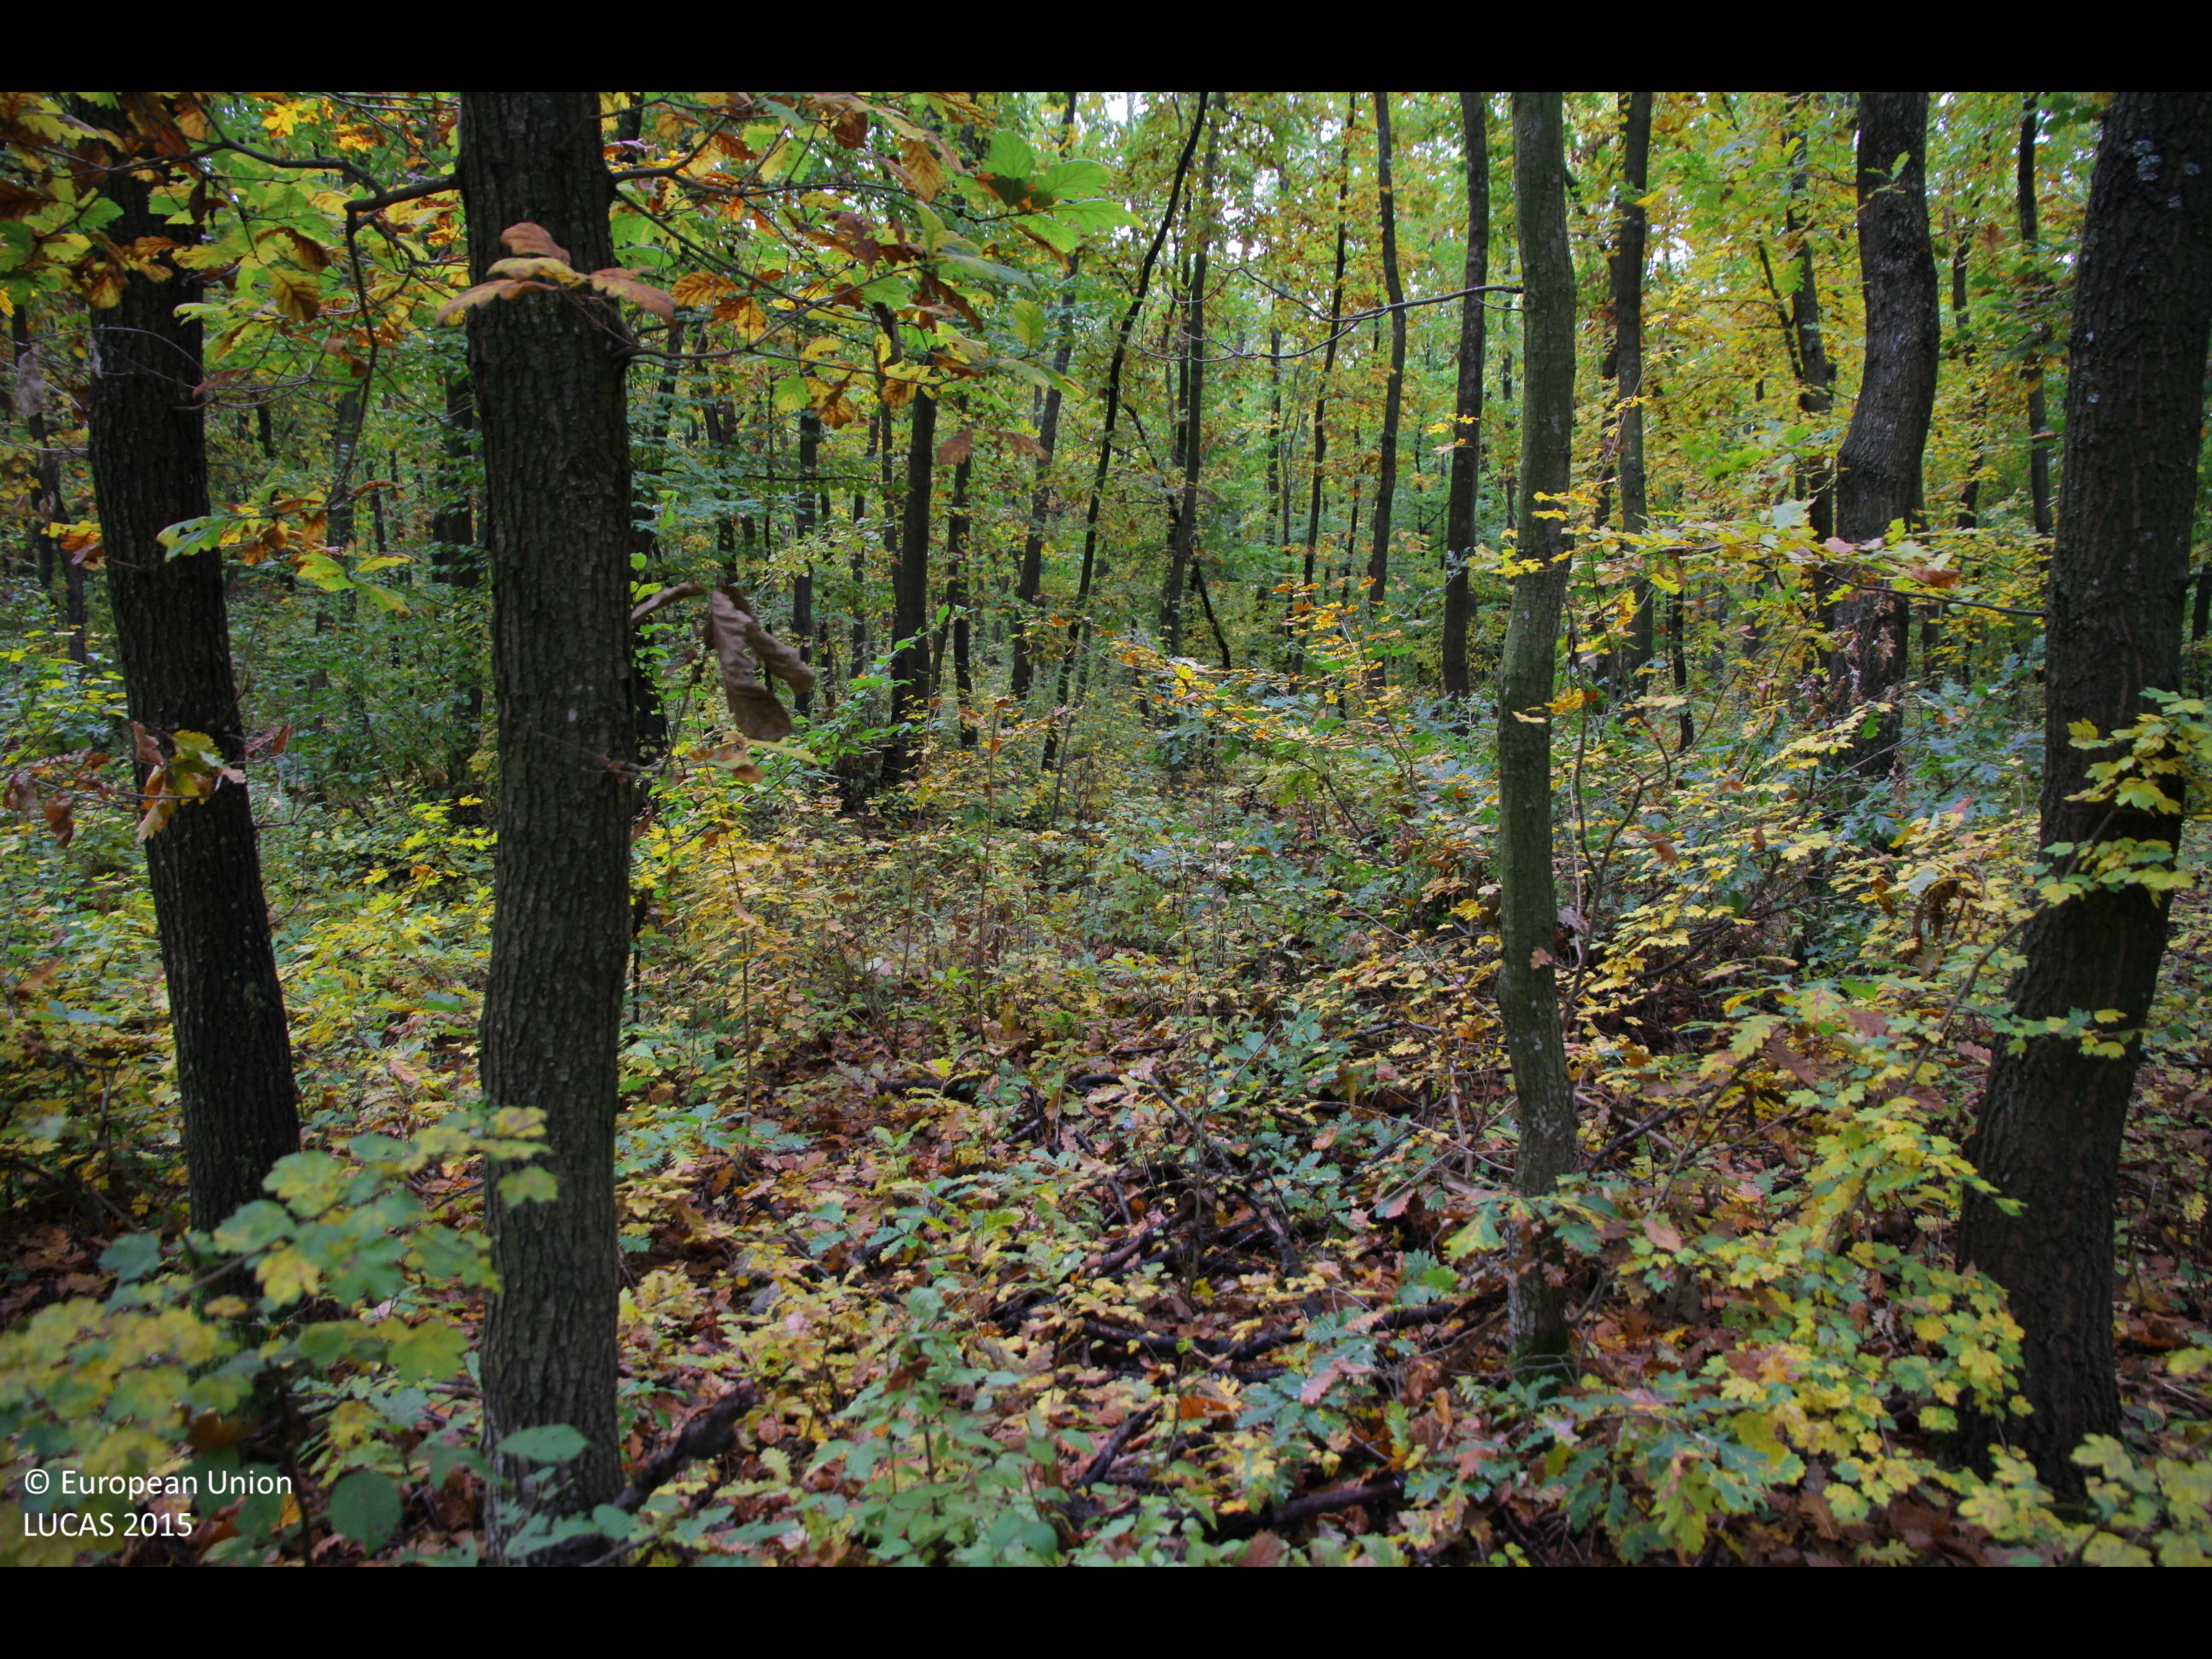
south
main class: Woodland
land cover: Broadleaved woodland
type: mesophytic deciduous forest
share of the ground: > 75 %
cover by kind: broadleaved forest trees 100 %
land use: Forestry
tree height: > 5 m
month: October
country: BG
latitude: 43.5299
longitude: 26.8554
